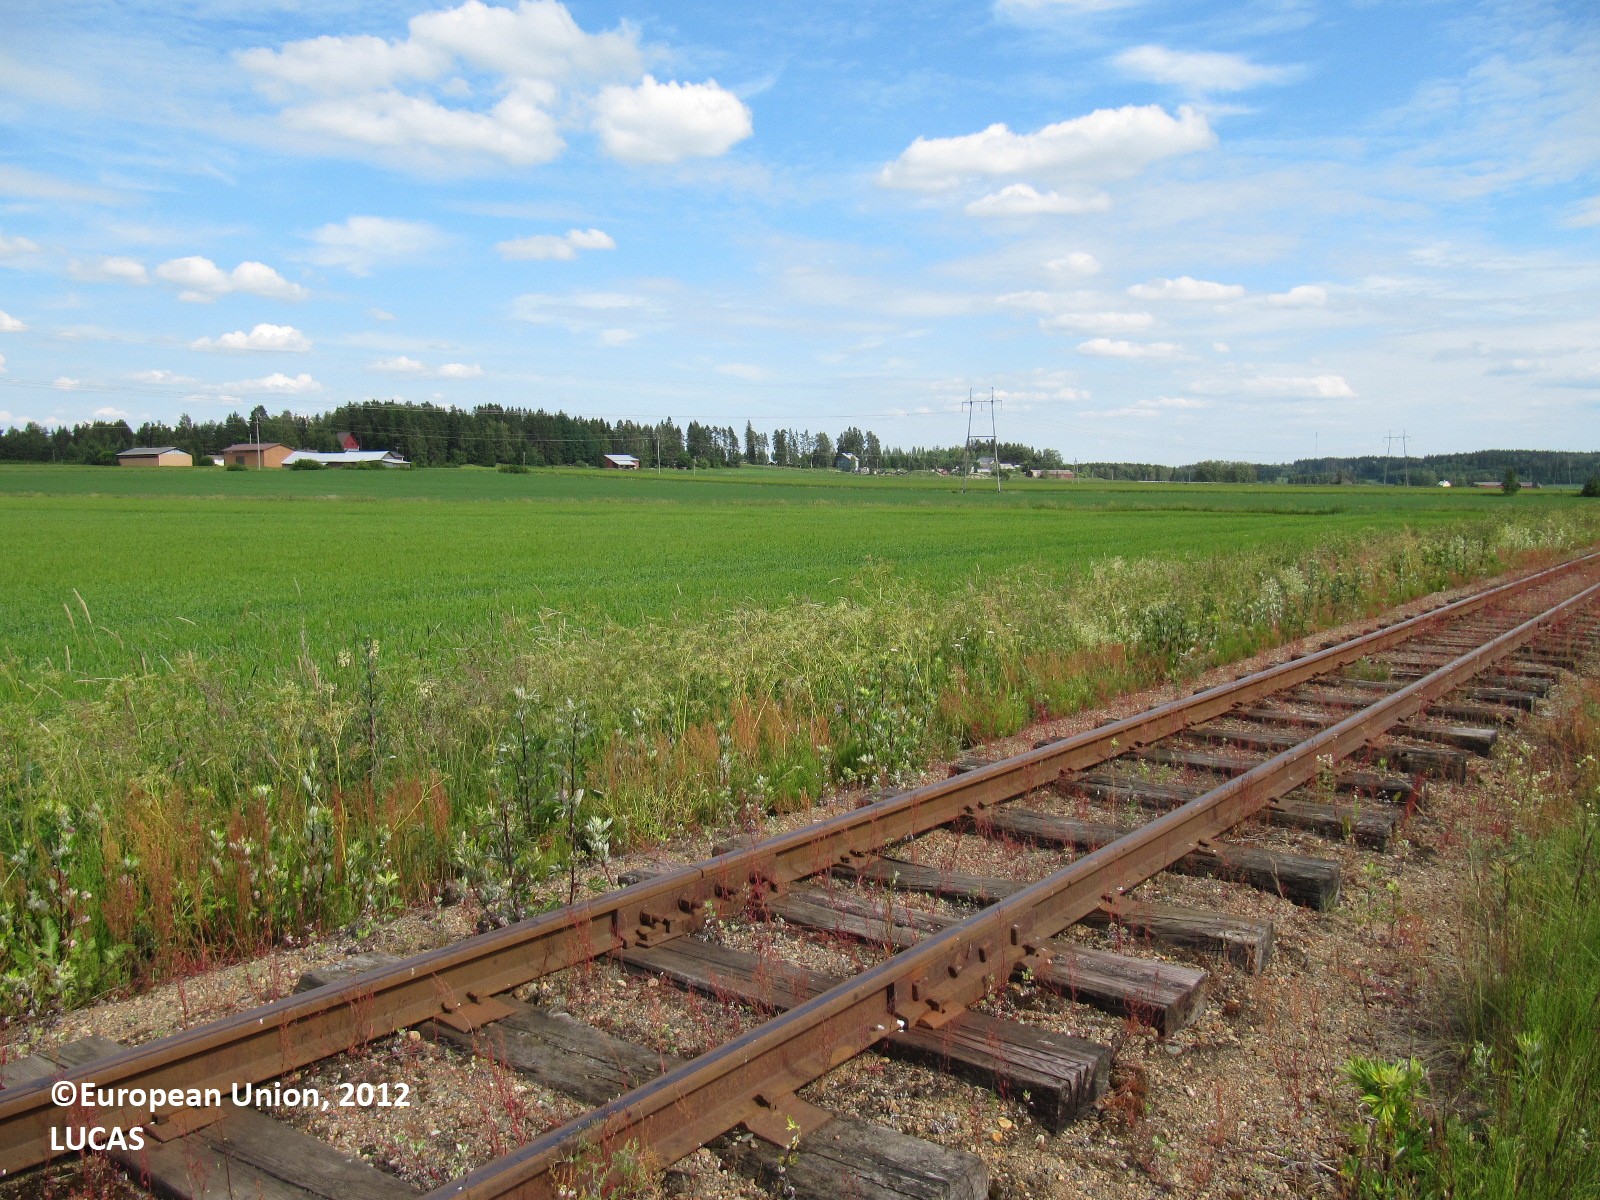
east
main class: Cropland
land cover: Barley
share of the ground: > 75 %
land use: Agriculture (excluding fallow land and kitchen gardens)
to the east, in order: Barley; Ditches and canals; Spontaneously vegetated surfaces; Railways; Spontaneously vegetated surfaces; Barley; Paved roads, cycling and walking lanes; Oats; Electric lines; Oats
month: July
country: FI
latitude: 60.8915
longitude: 23.4057
